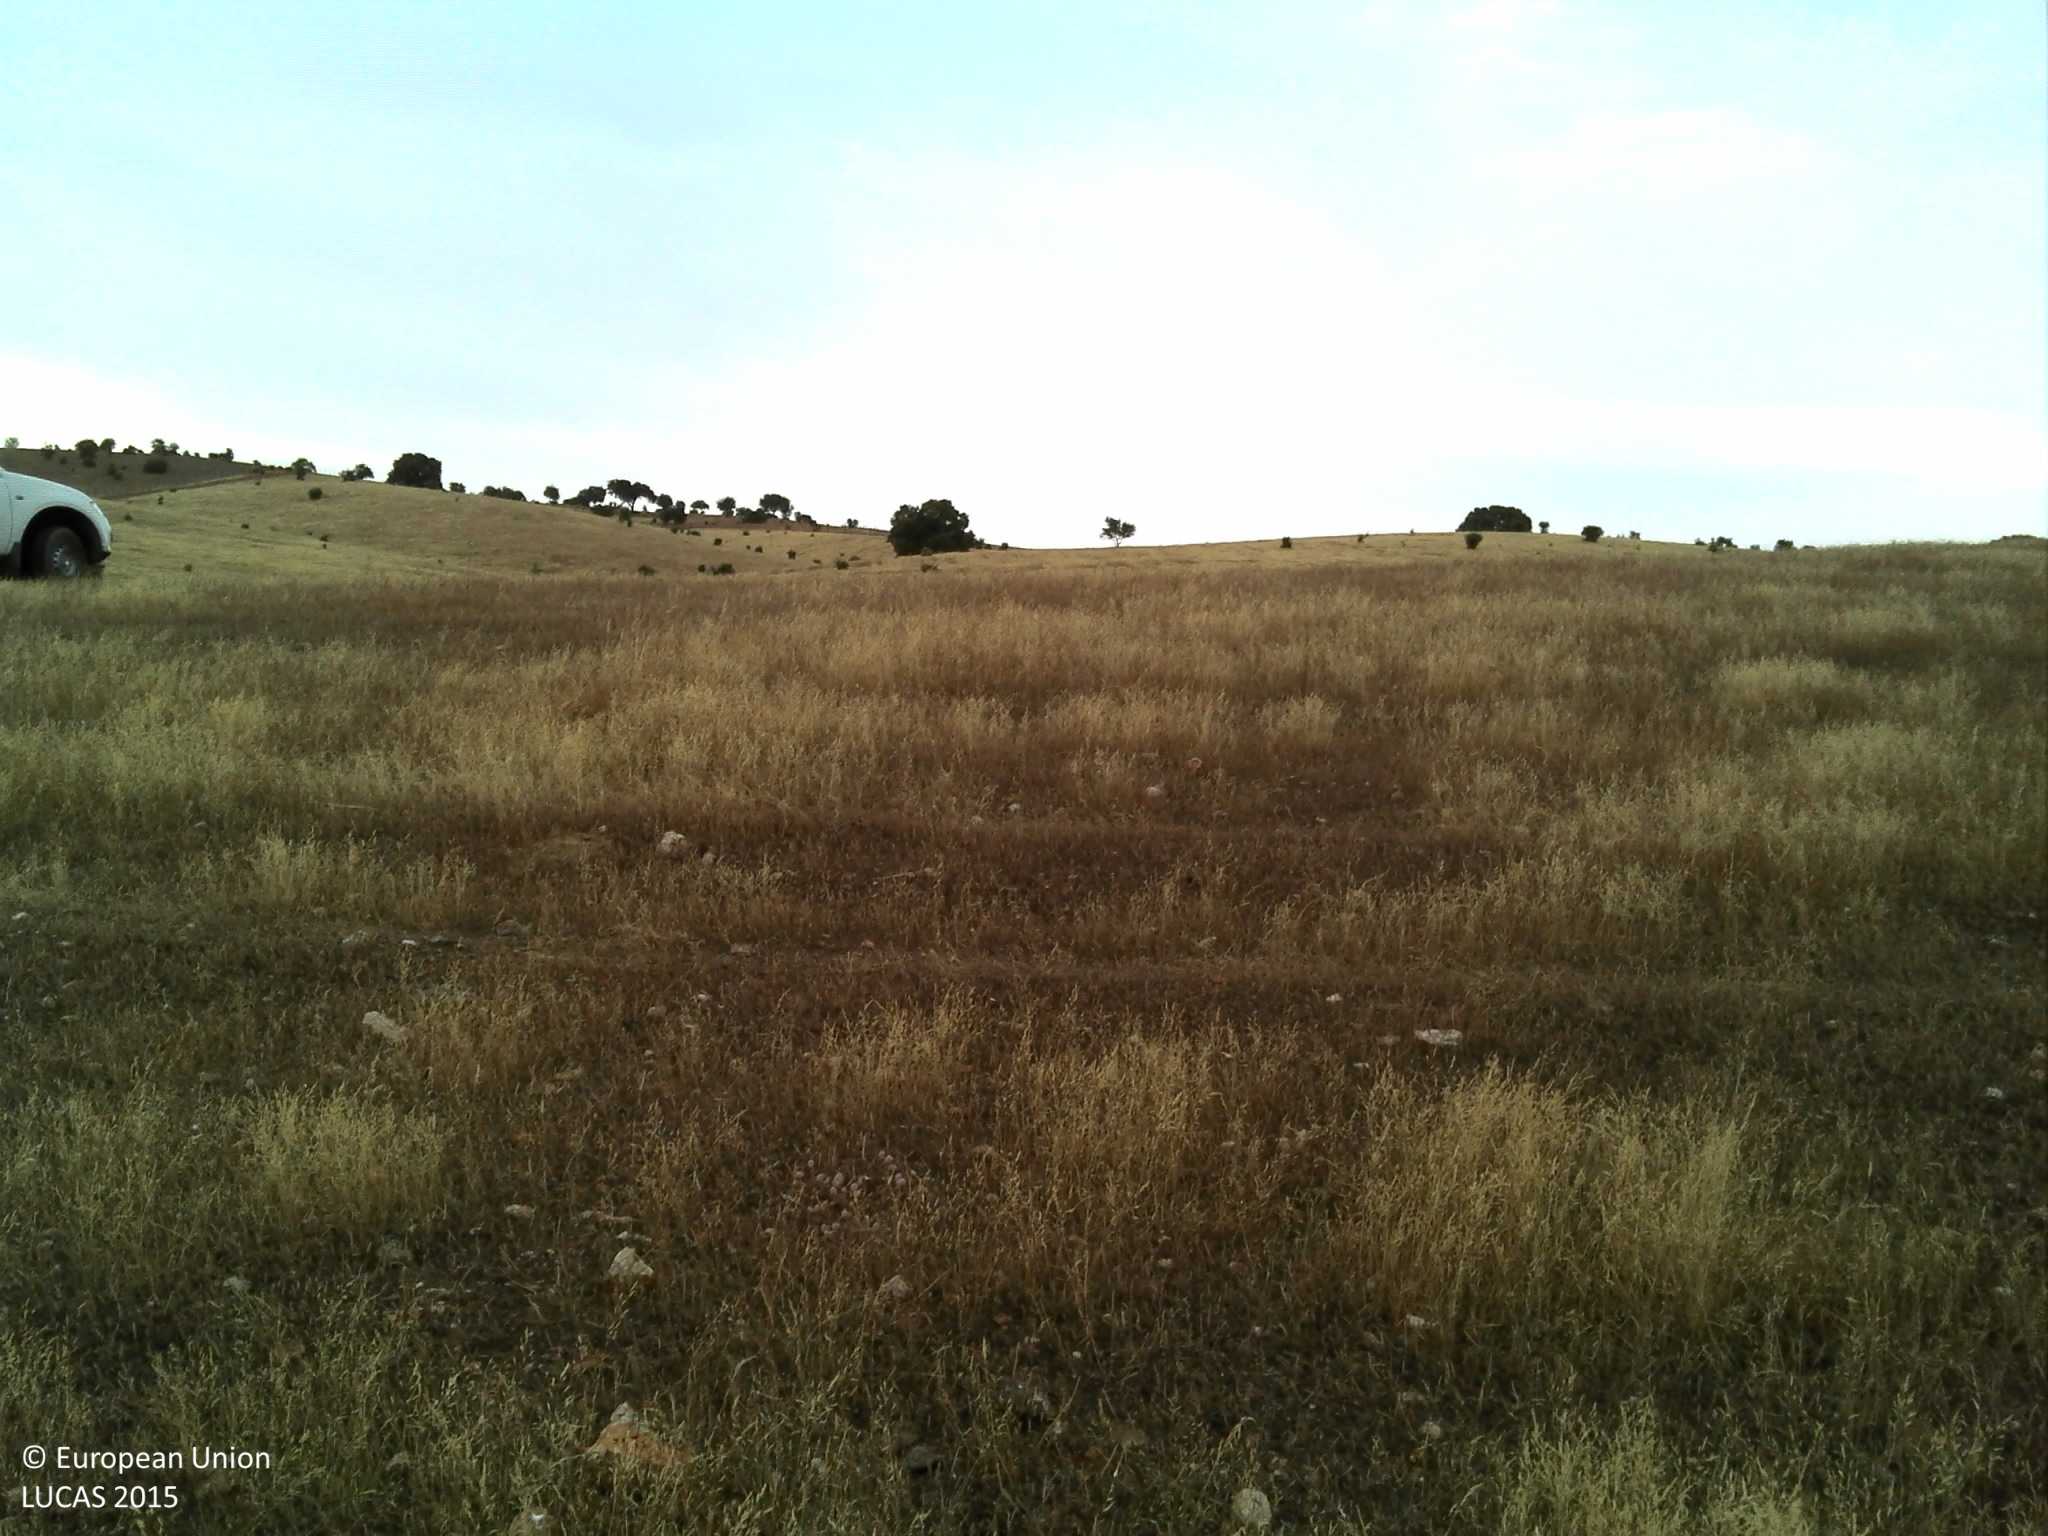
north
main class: Grassland
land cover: Grassland with sparse tree/shrub cover
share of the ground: > 75 %
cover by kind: herbaceous plants 95 %, broadleaved forest trees 5 %
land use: Agriculture (excluding fallow land and kitchen gardens)
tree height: < 5 m
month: June
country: PT
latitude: 37.7165
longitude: -7.5183
